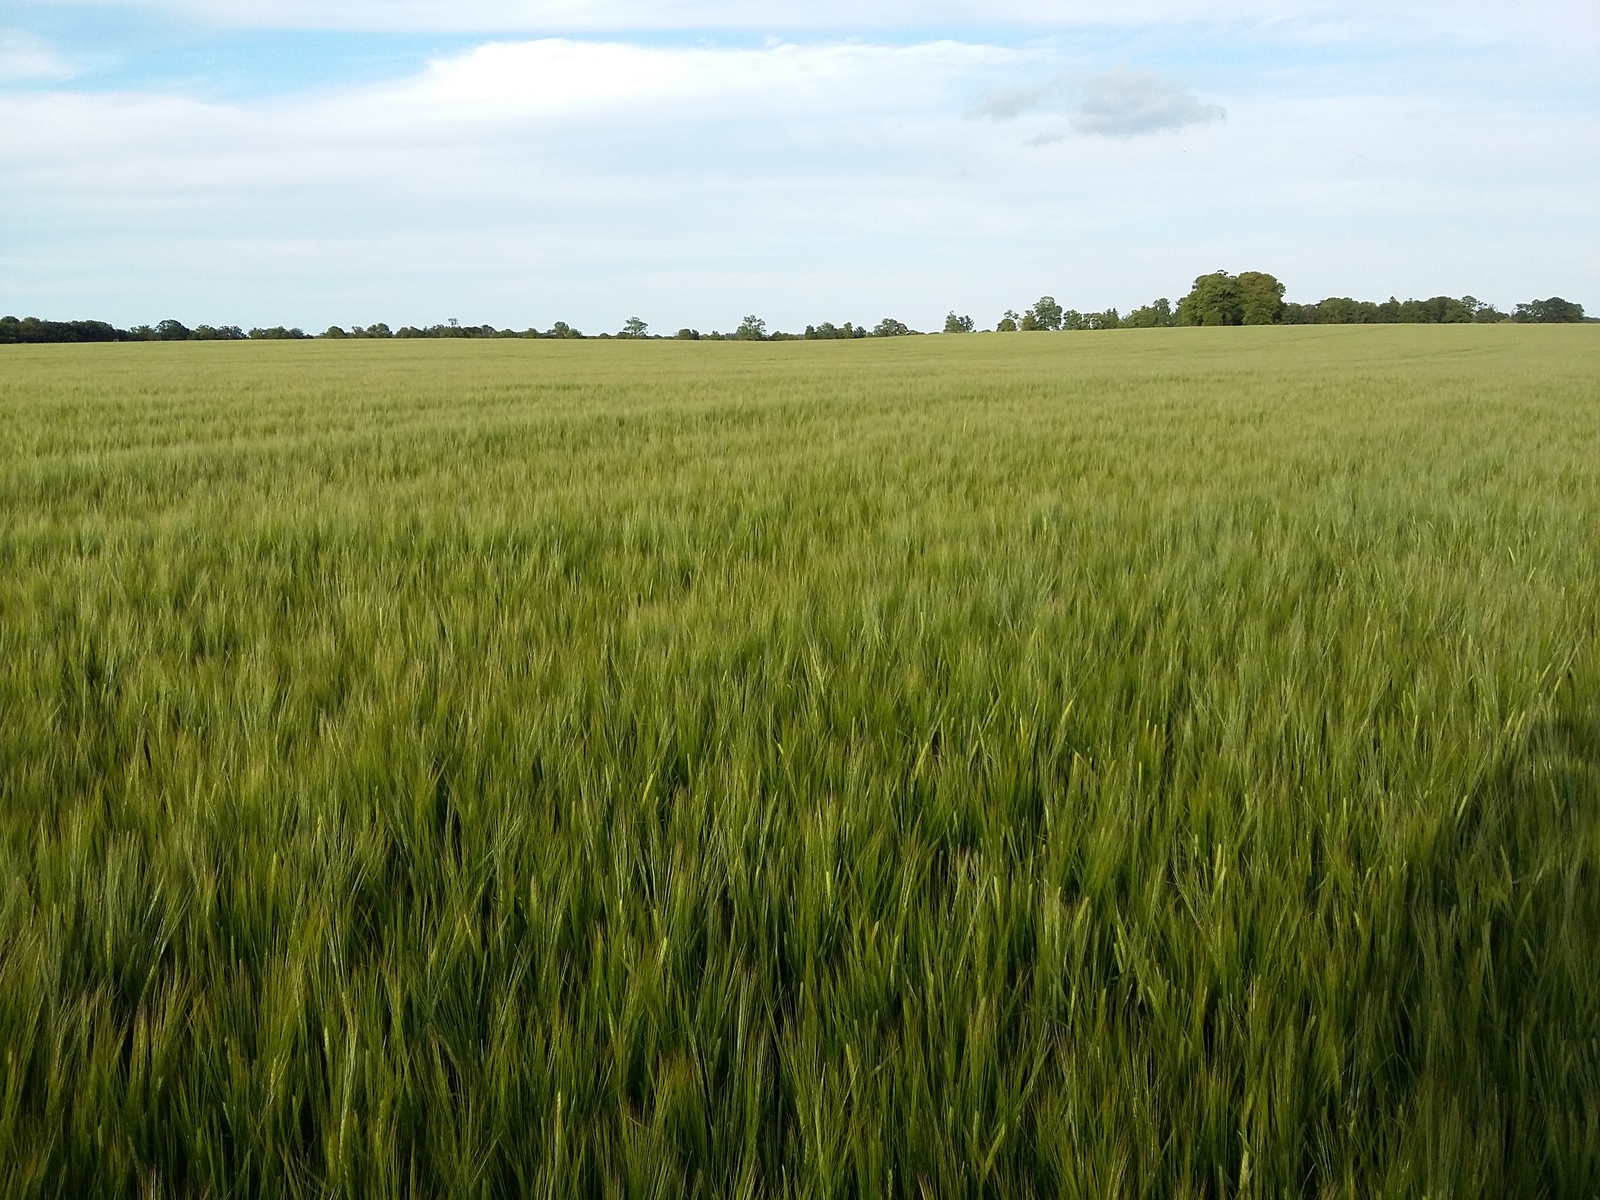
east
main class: Cropland
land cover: Barley
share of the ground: > 75 %
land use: Agriculture (excluding fallow land and kitchen gardens)
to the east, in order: Barley
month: June
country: DK
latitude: 54.7697
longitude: 12.0039
